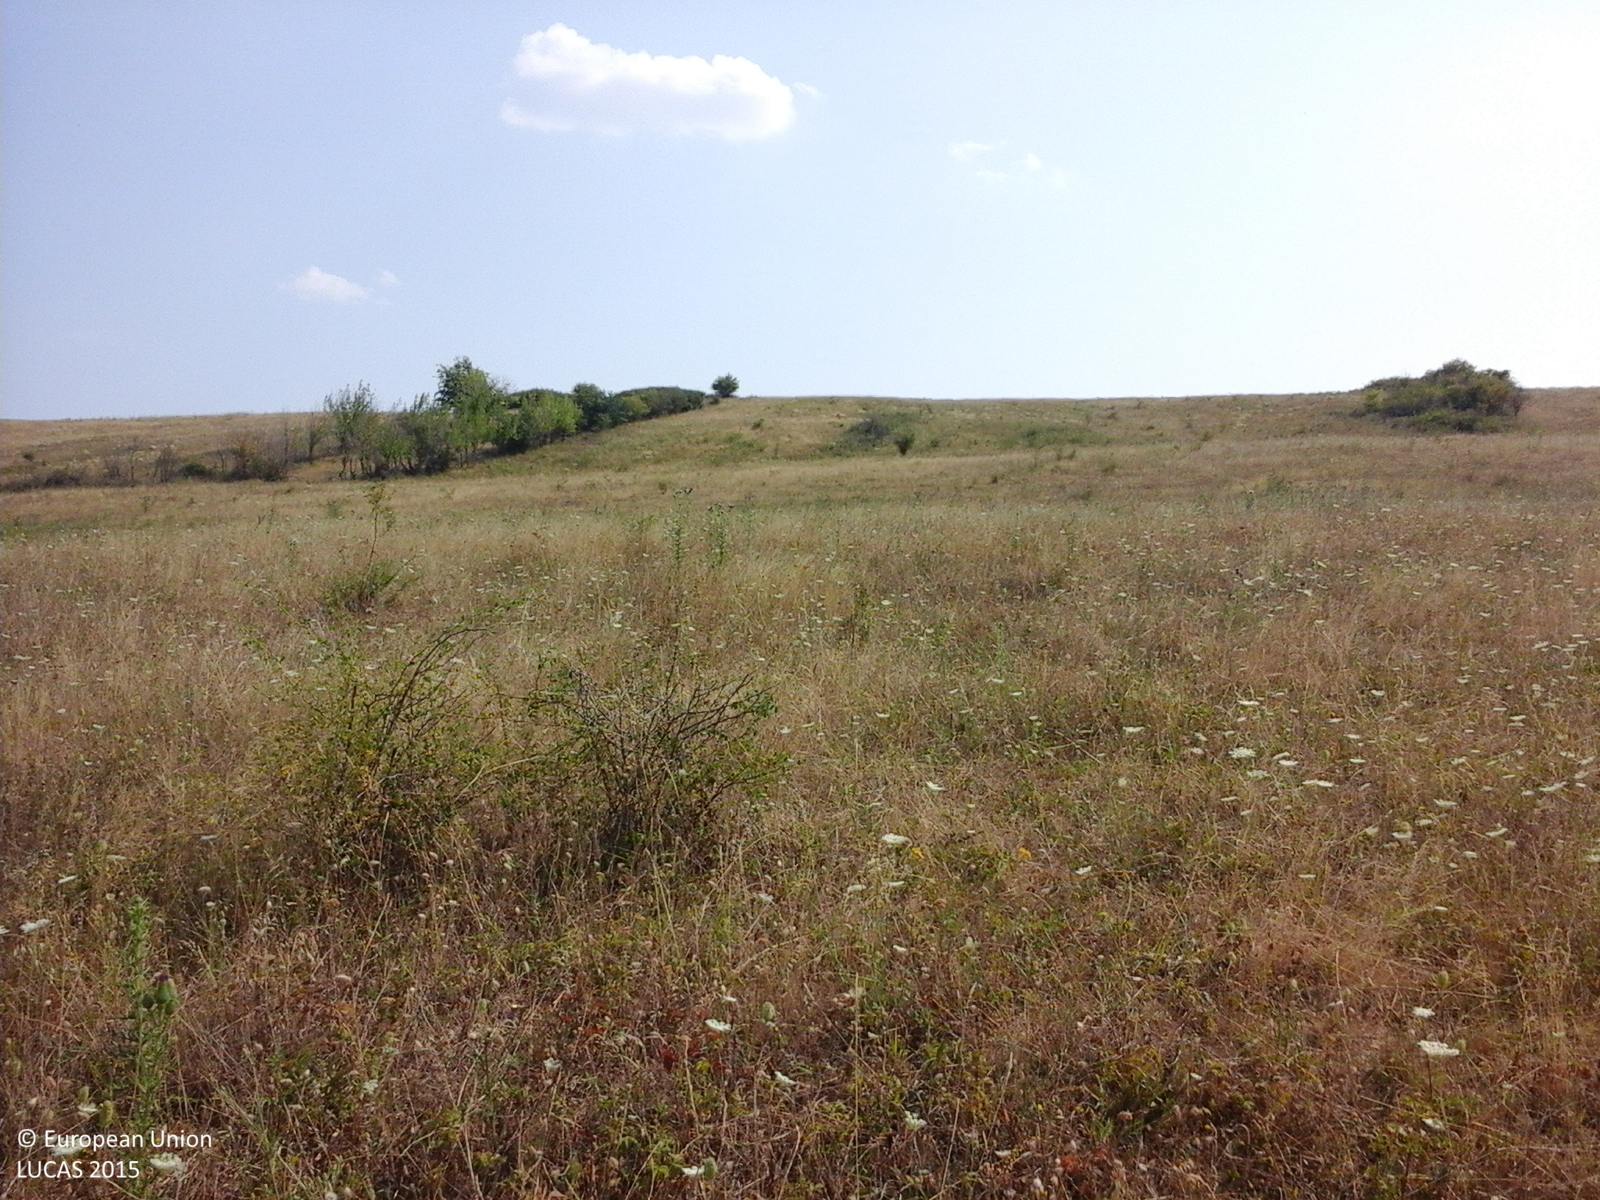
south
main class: Grassland
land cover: Spontaneously vegetated surfaces
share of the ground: > 75 %
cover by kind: herbaceous plants 100 %
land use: Fallow land
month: August
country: RO
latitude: 44.4566
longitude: 23.3088
